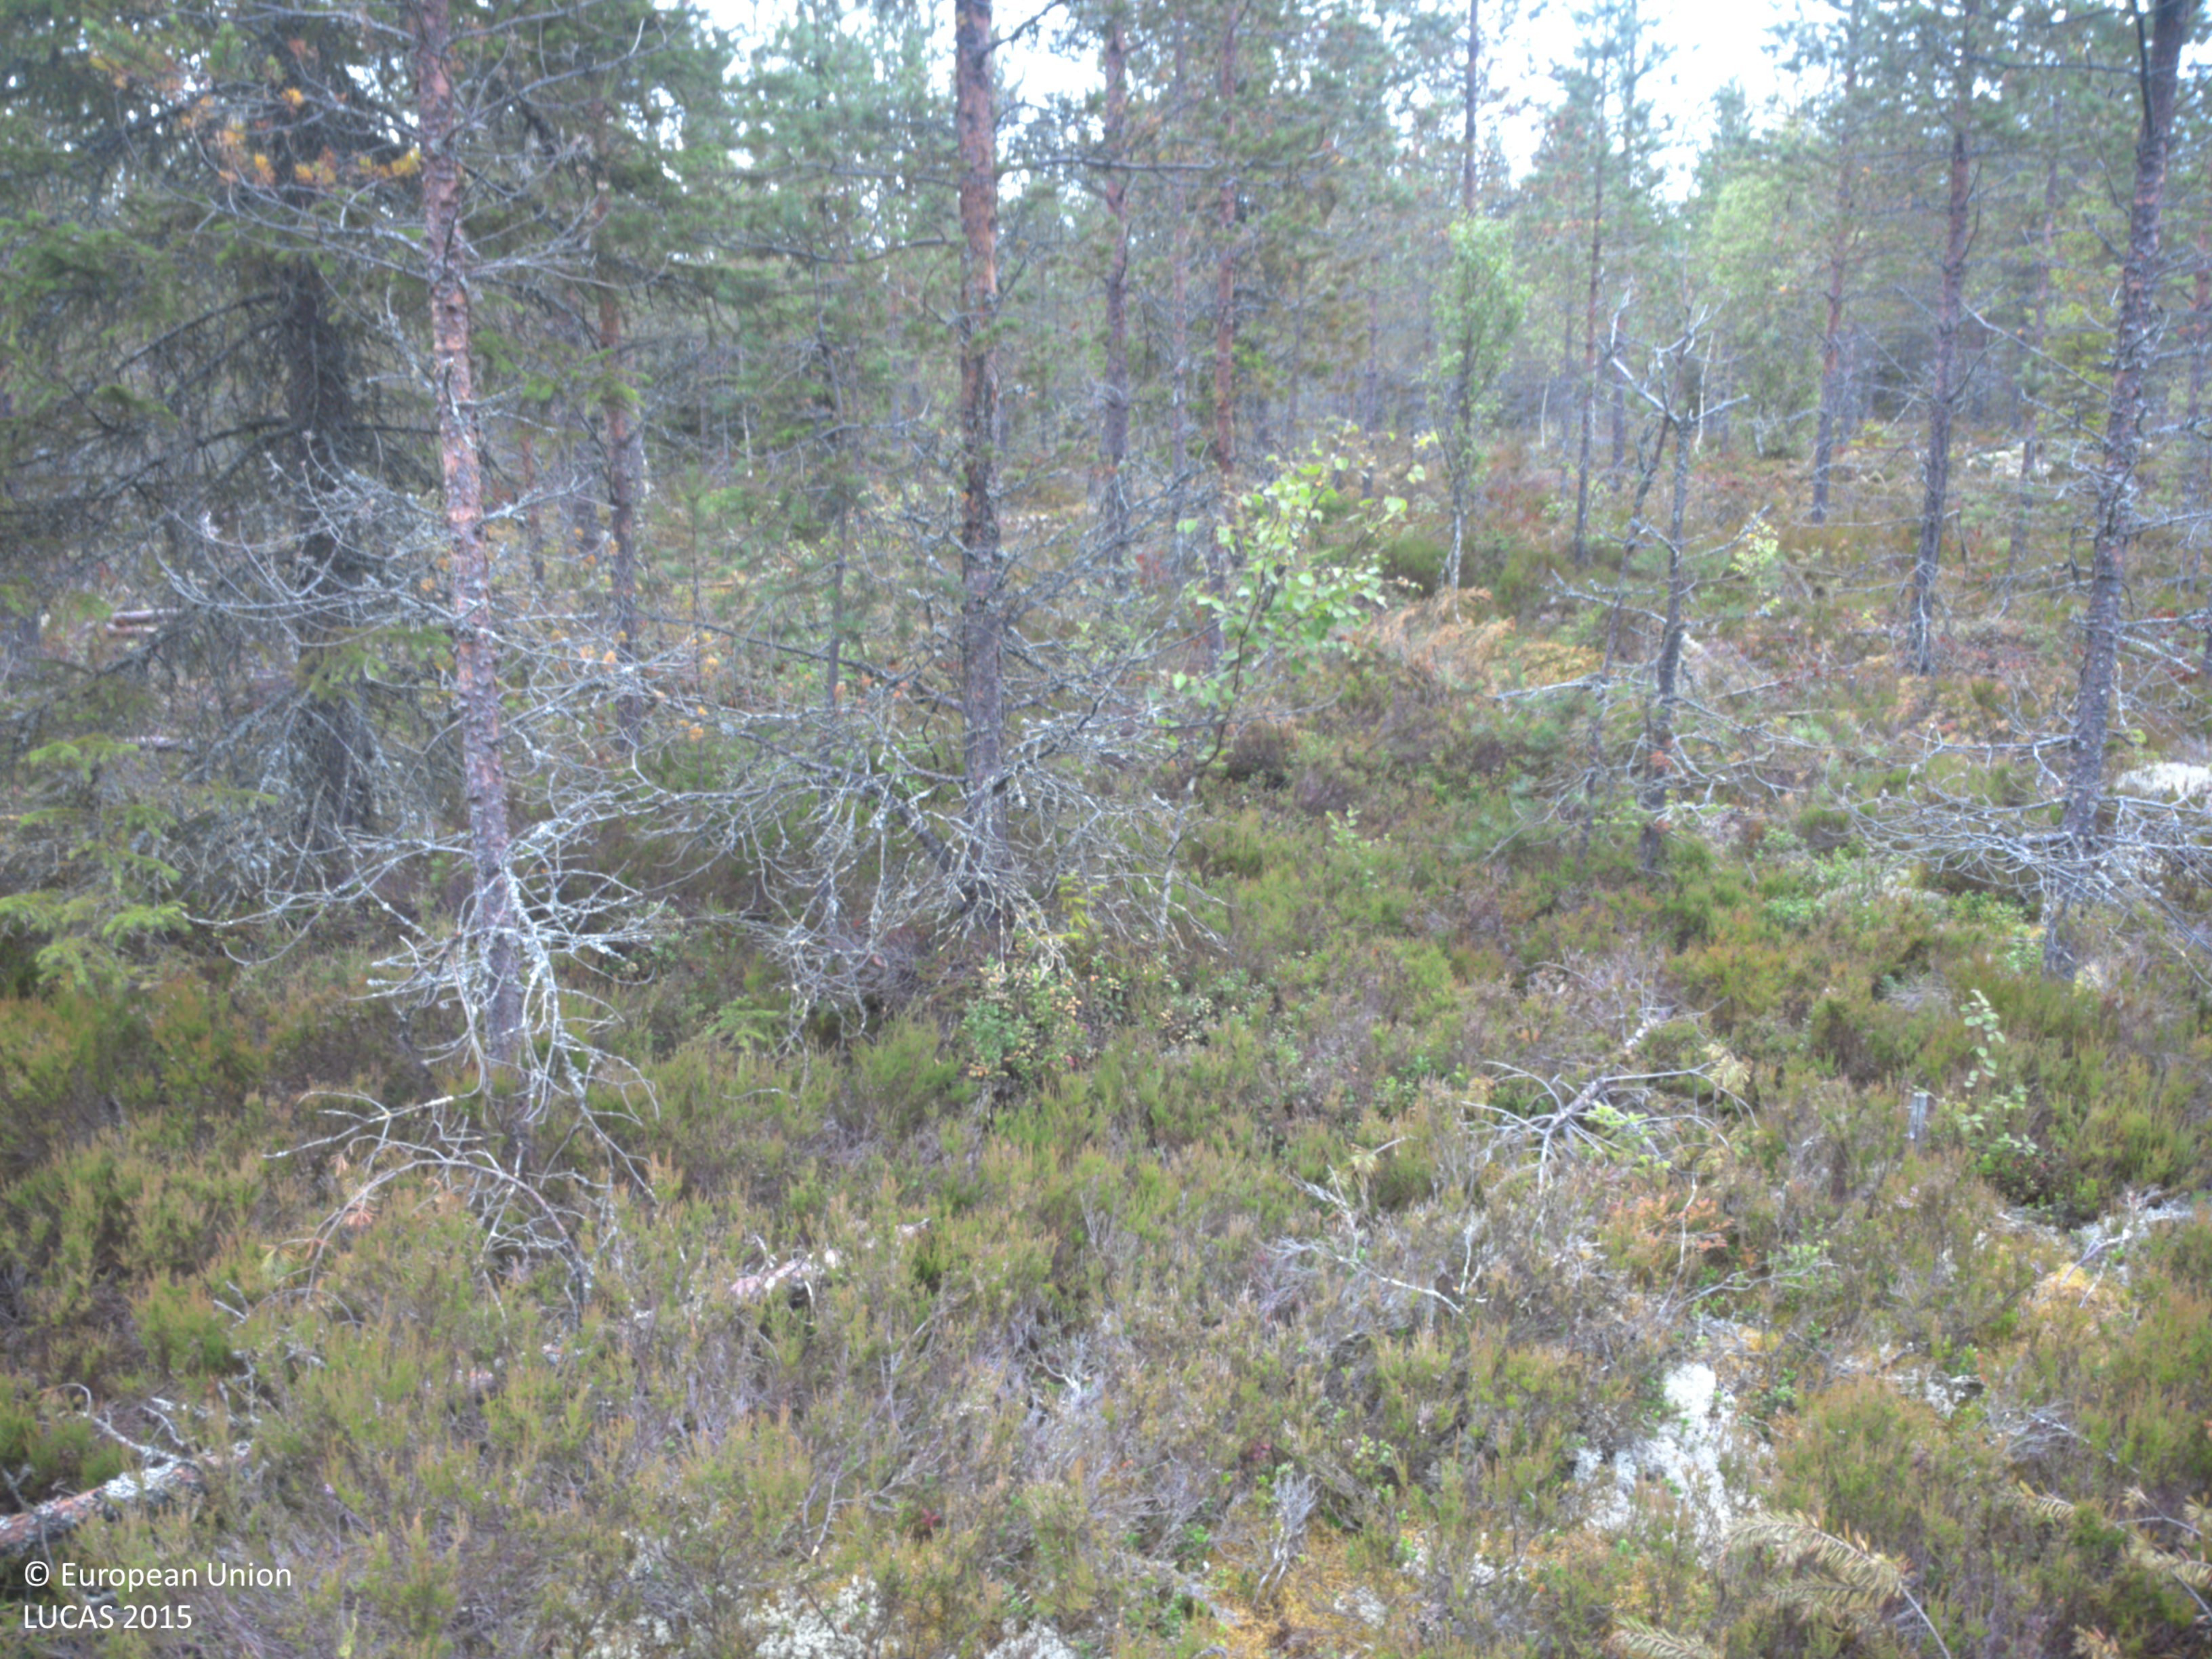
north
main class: Woodland
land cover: Pine dominated coniferous woodland
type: boreal forest
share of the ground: 25 - 50 %
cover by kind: lichens and mosses 50 %, coniferous forest trees 25 %, shrubs 20 %, broadleaved forest trees 5 %
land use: Forestry
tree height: > 5 m
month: August
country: SE
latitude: 63.6816
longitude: 19.7037
